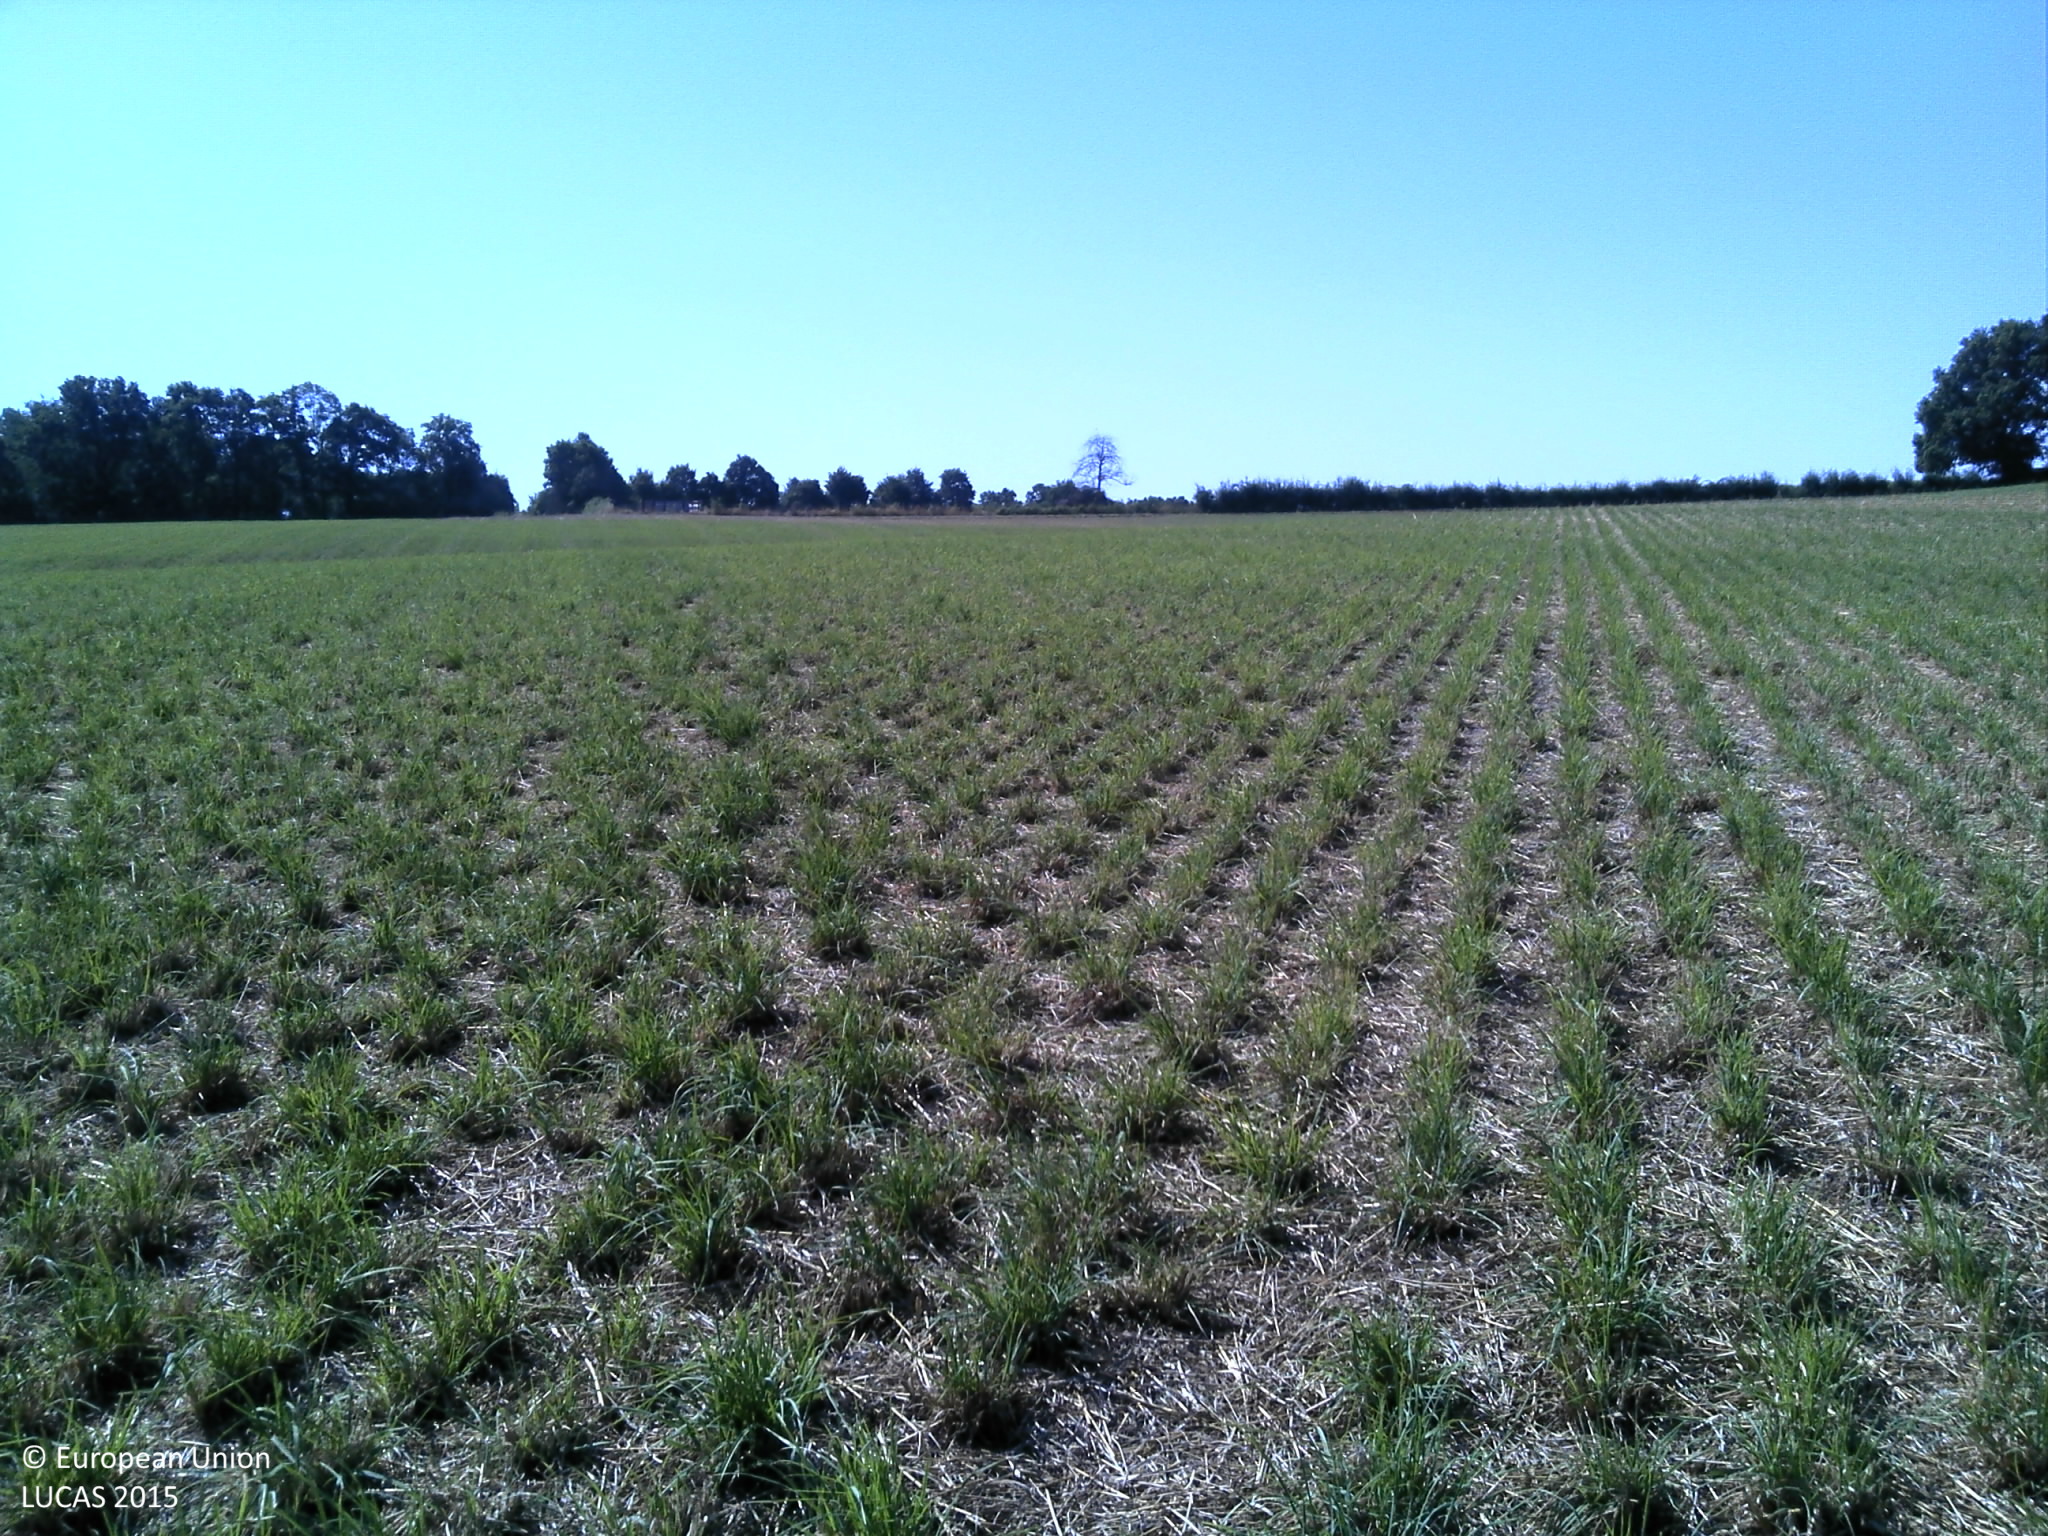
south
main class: Cropland
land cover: Temporary grasslands
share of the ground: > 75 %
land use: Agriculture (excluding fallow land and kitchen gardens)
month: August
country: FR
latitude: 49.1670
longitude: 4.8543
